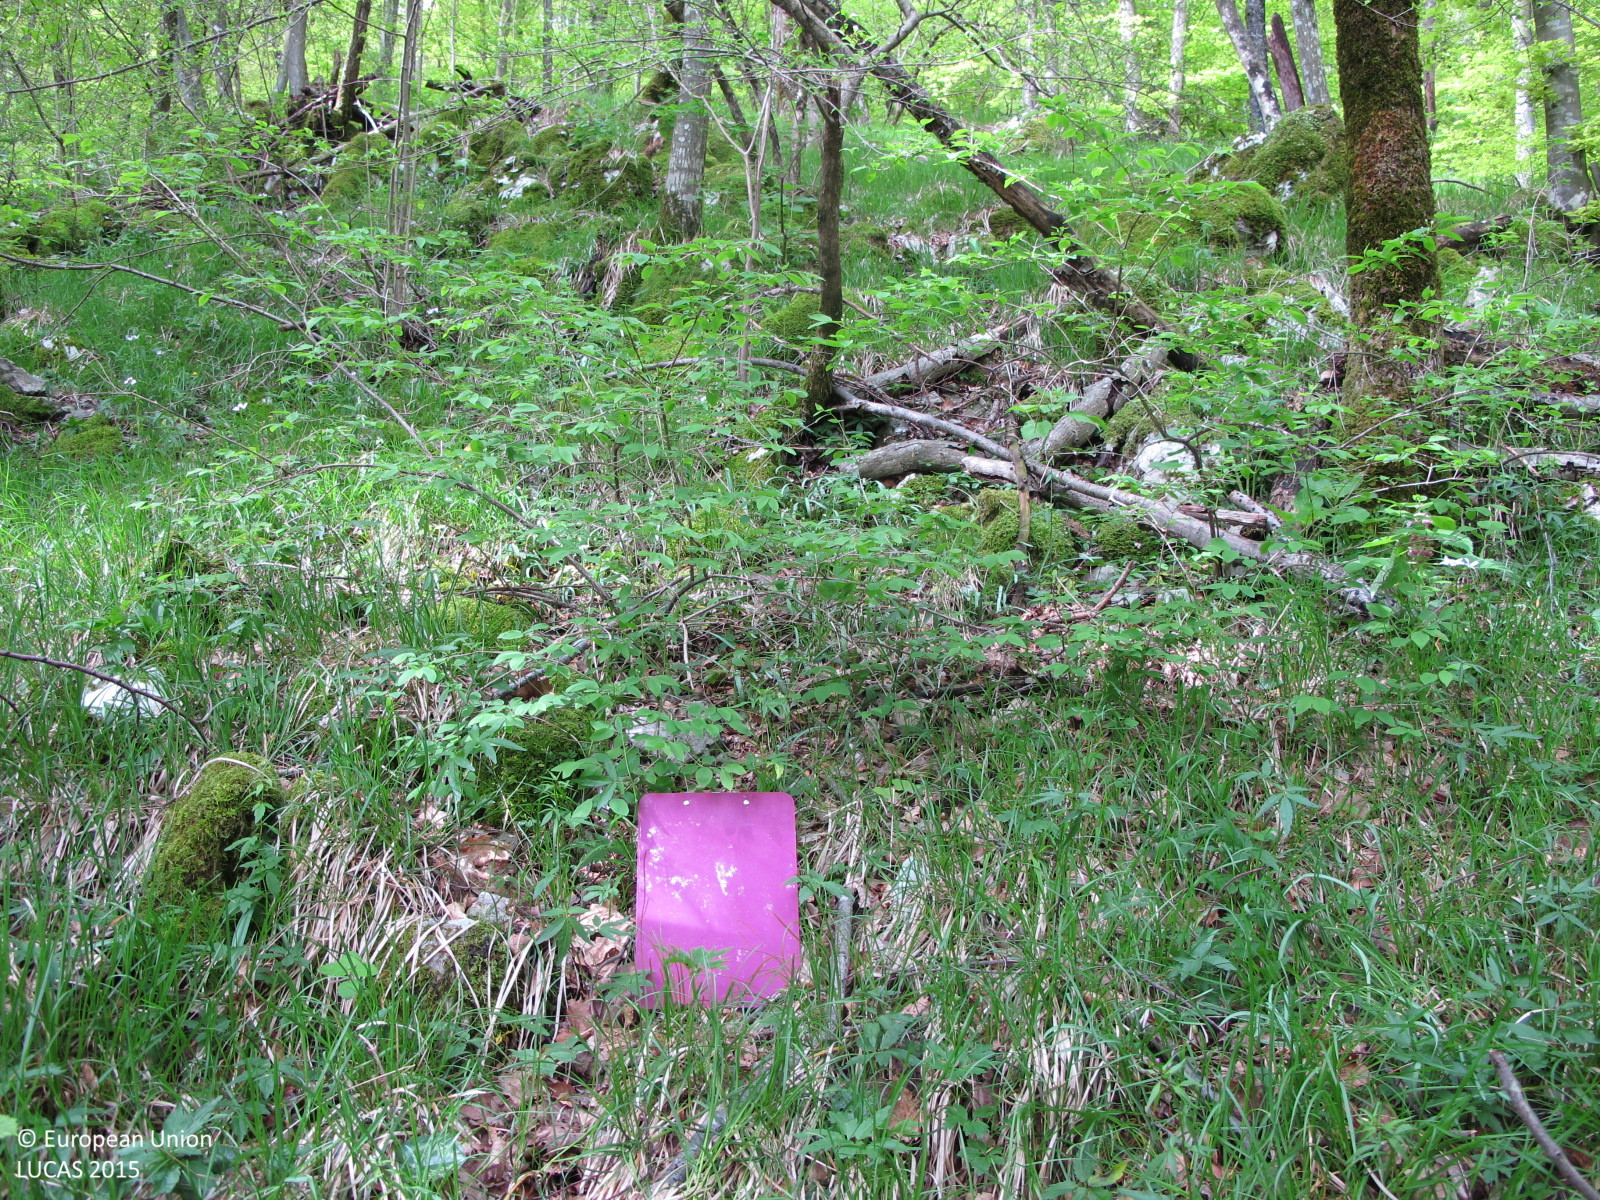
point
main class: Woodland
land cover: Broadleaved woodland
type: beech forest
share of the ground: > 75 %
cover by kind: broadleaved forest trees 80 %, herbaceous plants 10 %, shrubs 5 %
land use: Forestry
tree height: > 5 m
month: May
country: HR
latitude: 45.3289
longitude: 14.2437
